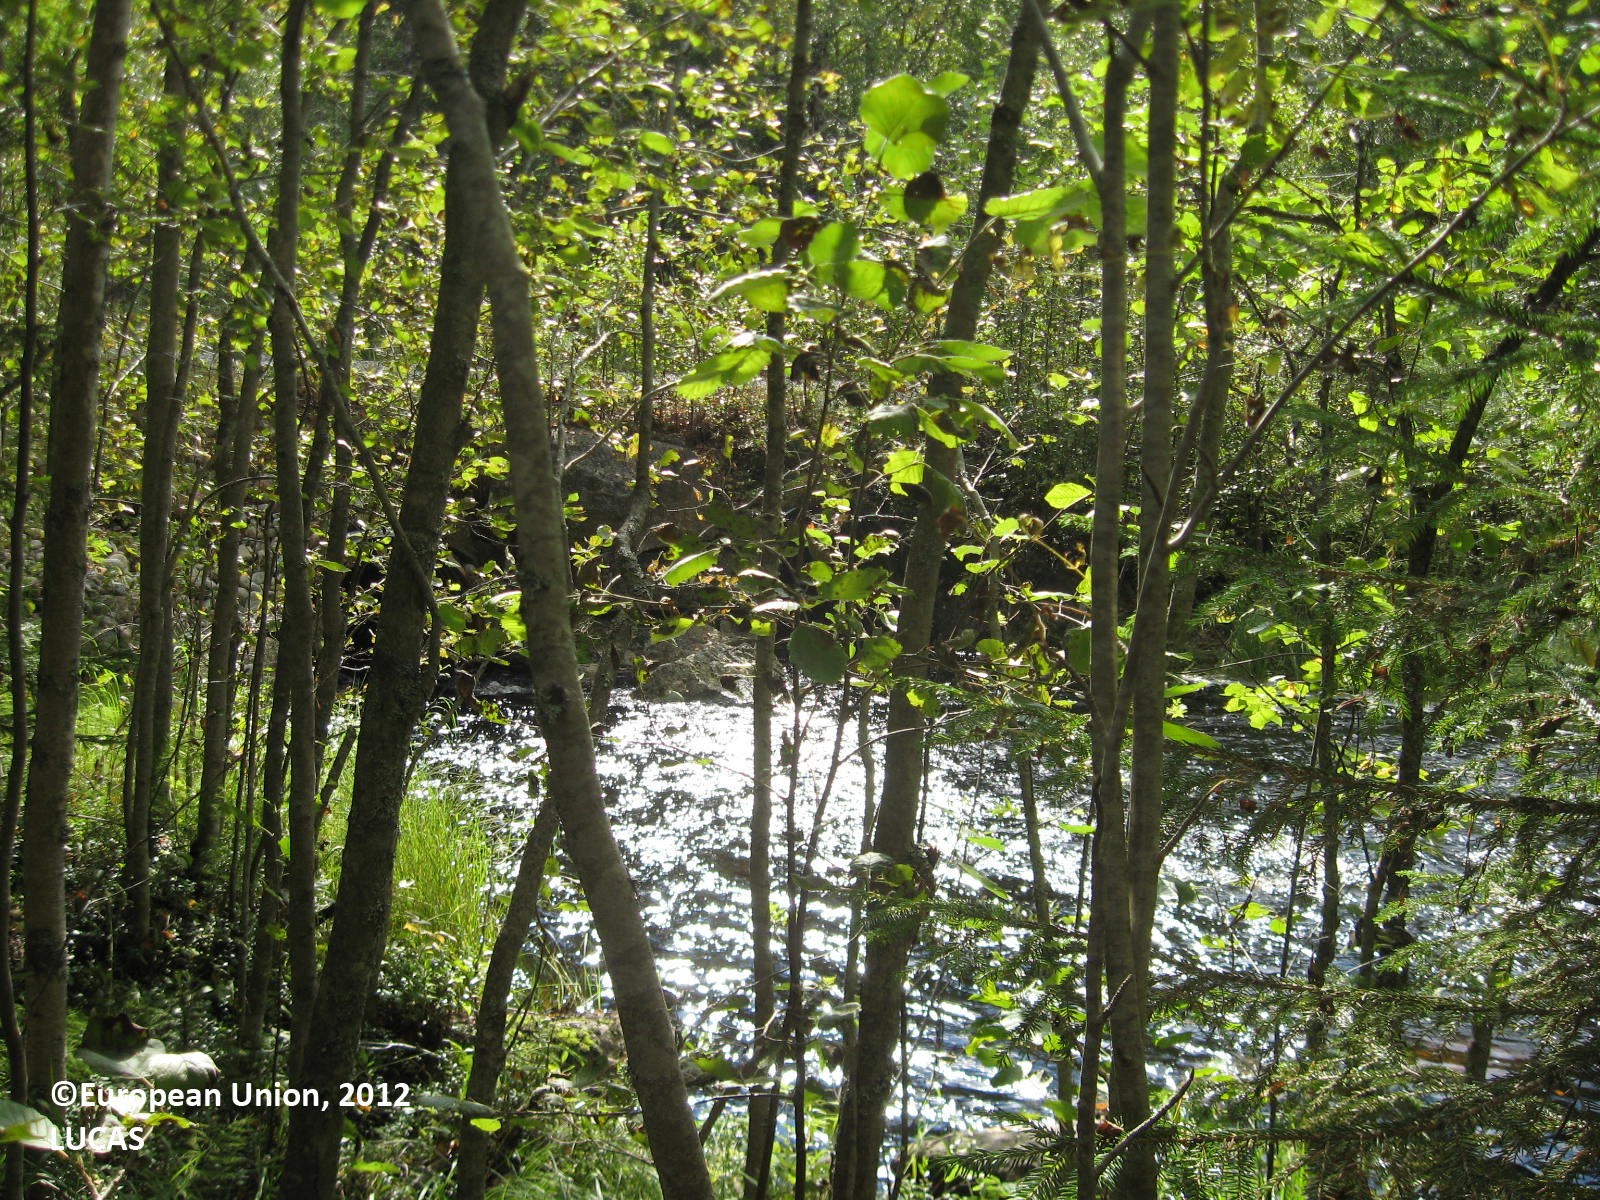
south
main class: Woodland
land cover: Pine dominated mixed woodland
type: boreal forest
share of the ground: > 75 %
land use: Forestry
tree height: > 5 m
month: August
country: FI
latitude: 63.5742
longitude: 30.2571
